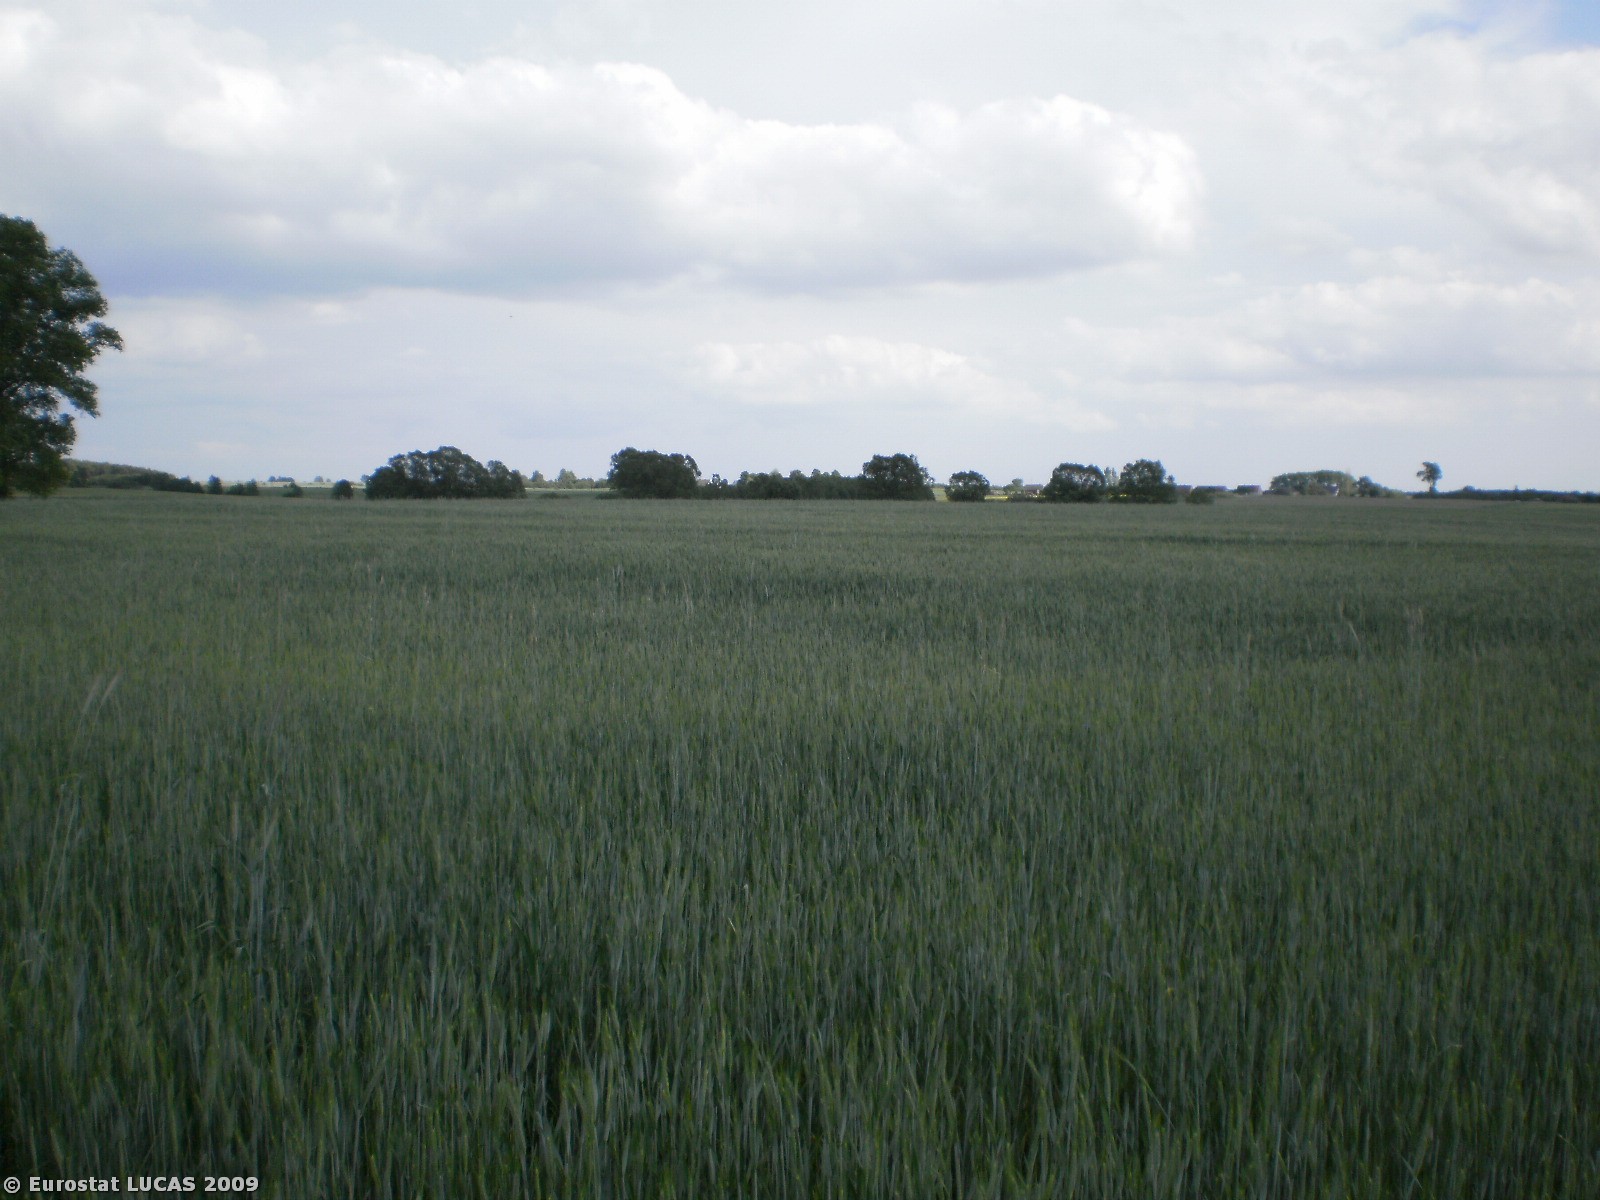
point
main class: Cropland
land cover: Triticale
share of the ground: > 75 %
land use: Agriculture (excluding fallow land and kitchen gardens)
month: May
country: PL
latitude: 53.2826
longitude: 17.7075
